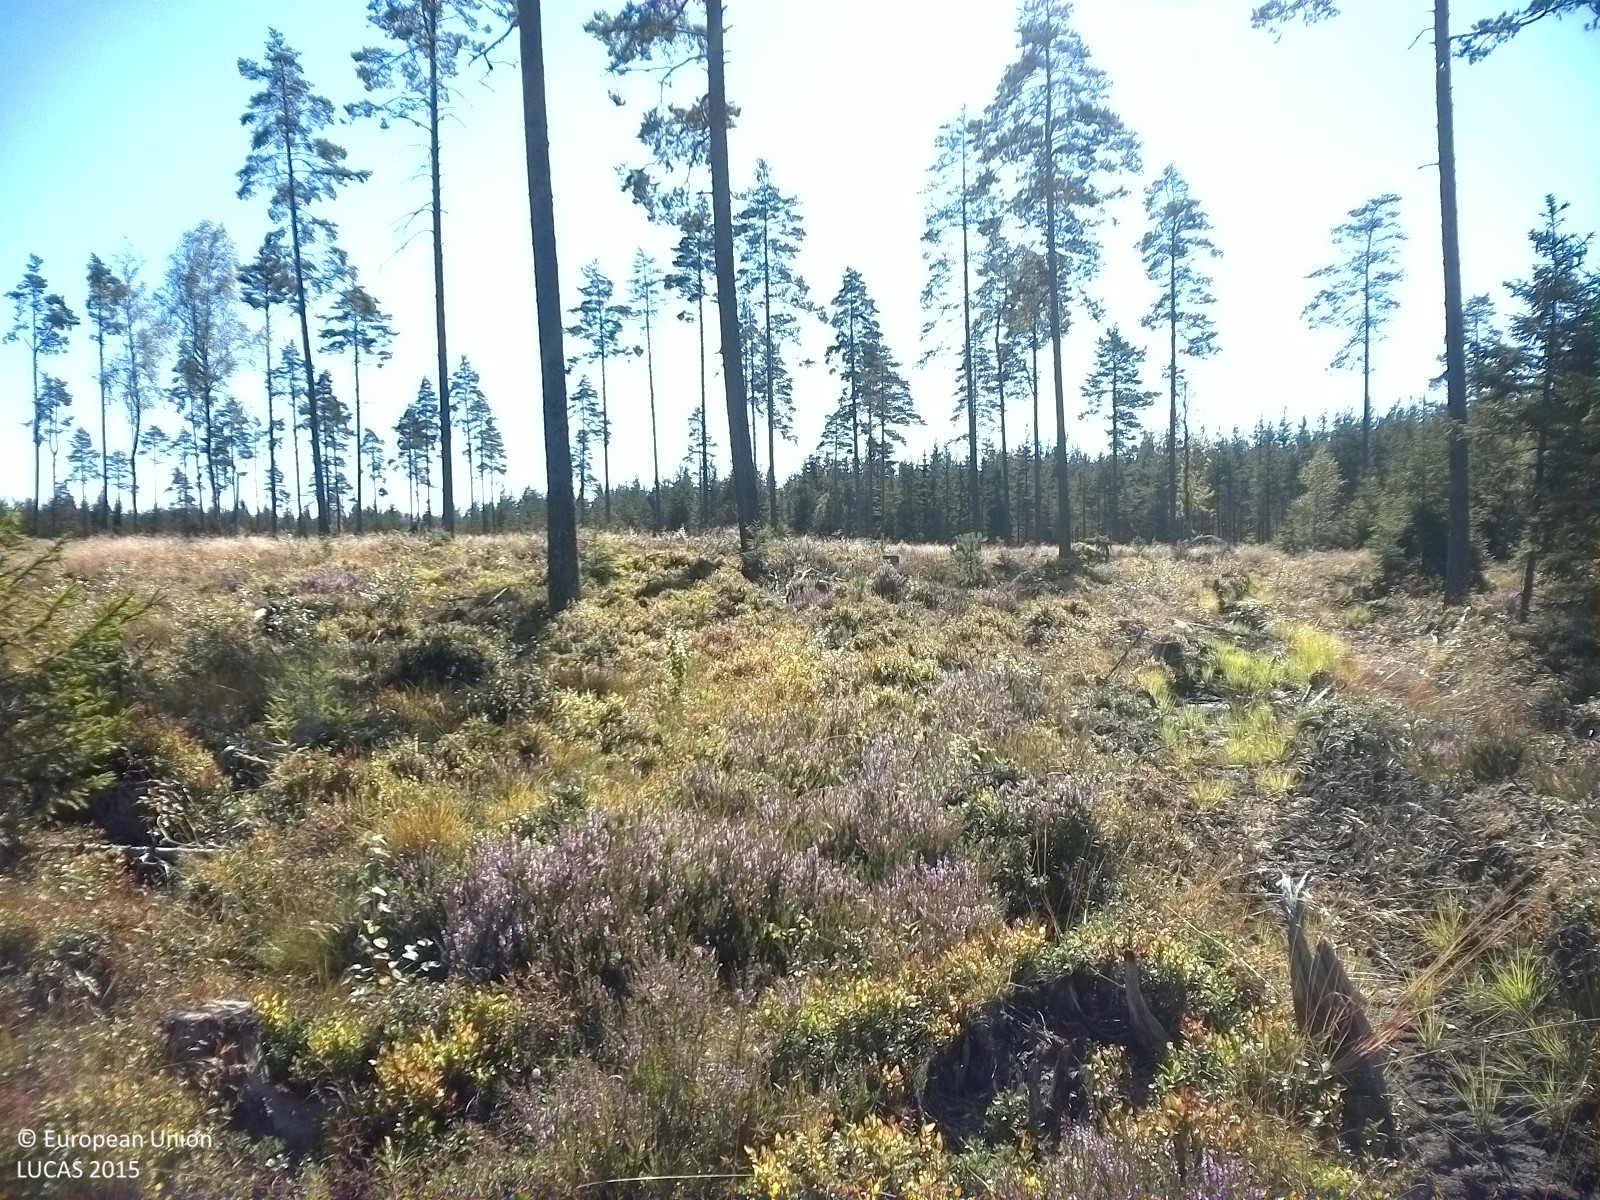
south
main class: Woodland
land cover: Pine dominated coniferous woodland
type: boreal forest
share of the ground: 10 - 25 %
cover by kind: shrubs 45 %, herbaceous plants 25 %, coniferous forest trees 15 %, lichens and mosses 15 %
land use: Forestry
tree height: > 5 m
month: August
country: SE
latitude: 59.4173
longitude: 14.6960
